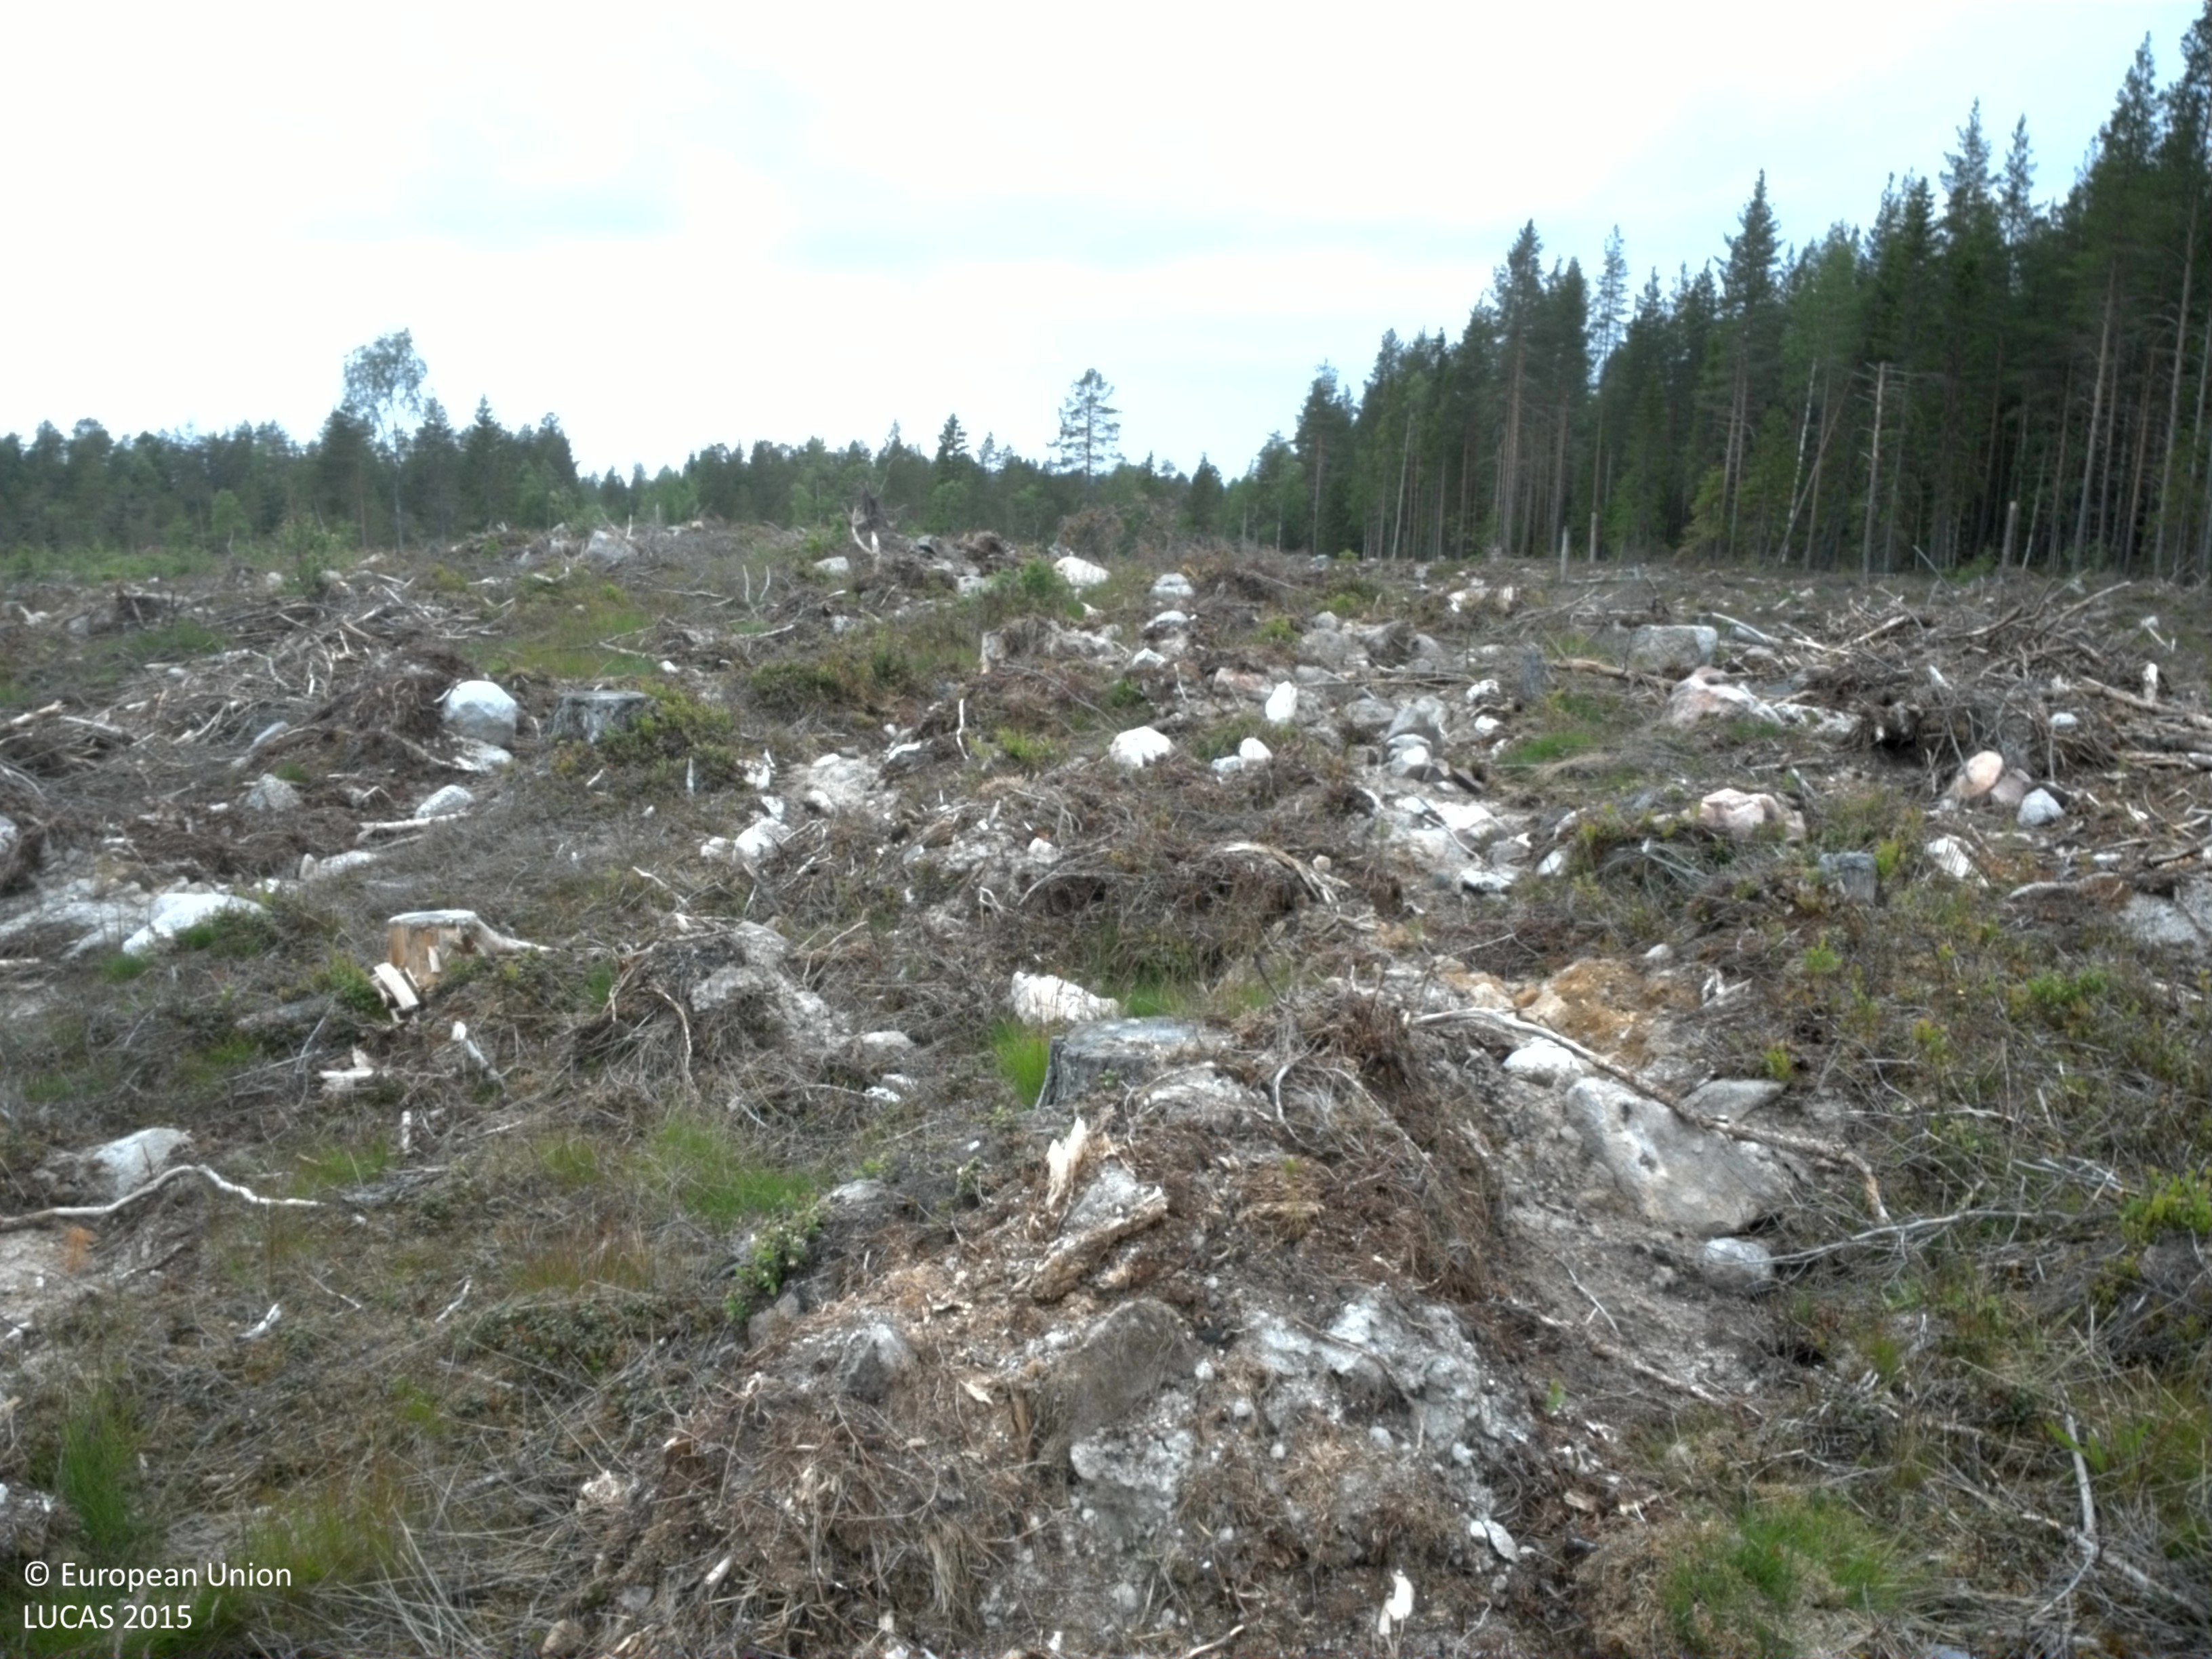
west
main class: Grassland
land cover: Grassland with sparse tree/shrub cover
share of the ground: 50 - 75 %
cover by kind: herbaceous plants 65 %, unconsolidated bare surface 20 %, shrubs 10 %, broadleaved forest trees 5 %
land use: Forestry
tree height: > 5 m
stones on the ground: 25 - 50 %
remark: Clear cut
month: July
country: SE
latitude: 64.4416
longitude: 20.6359
